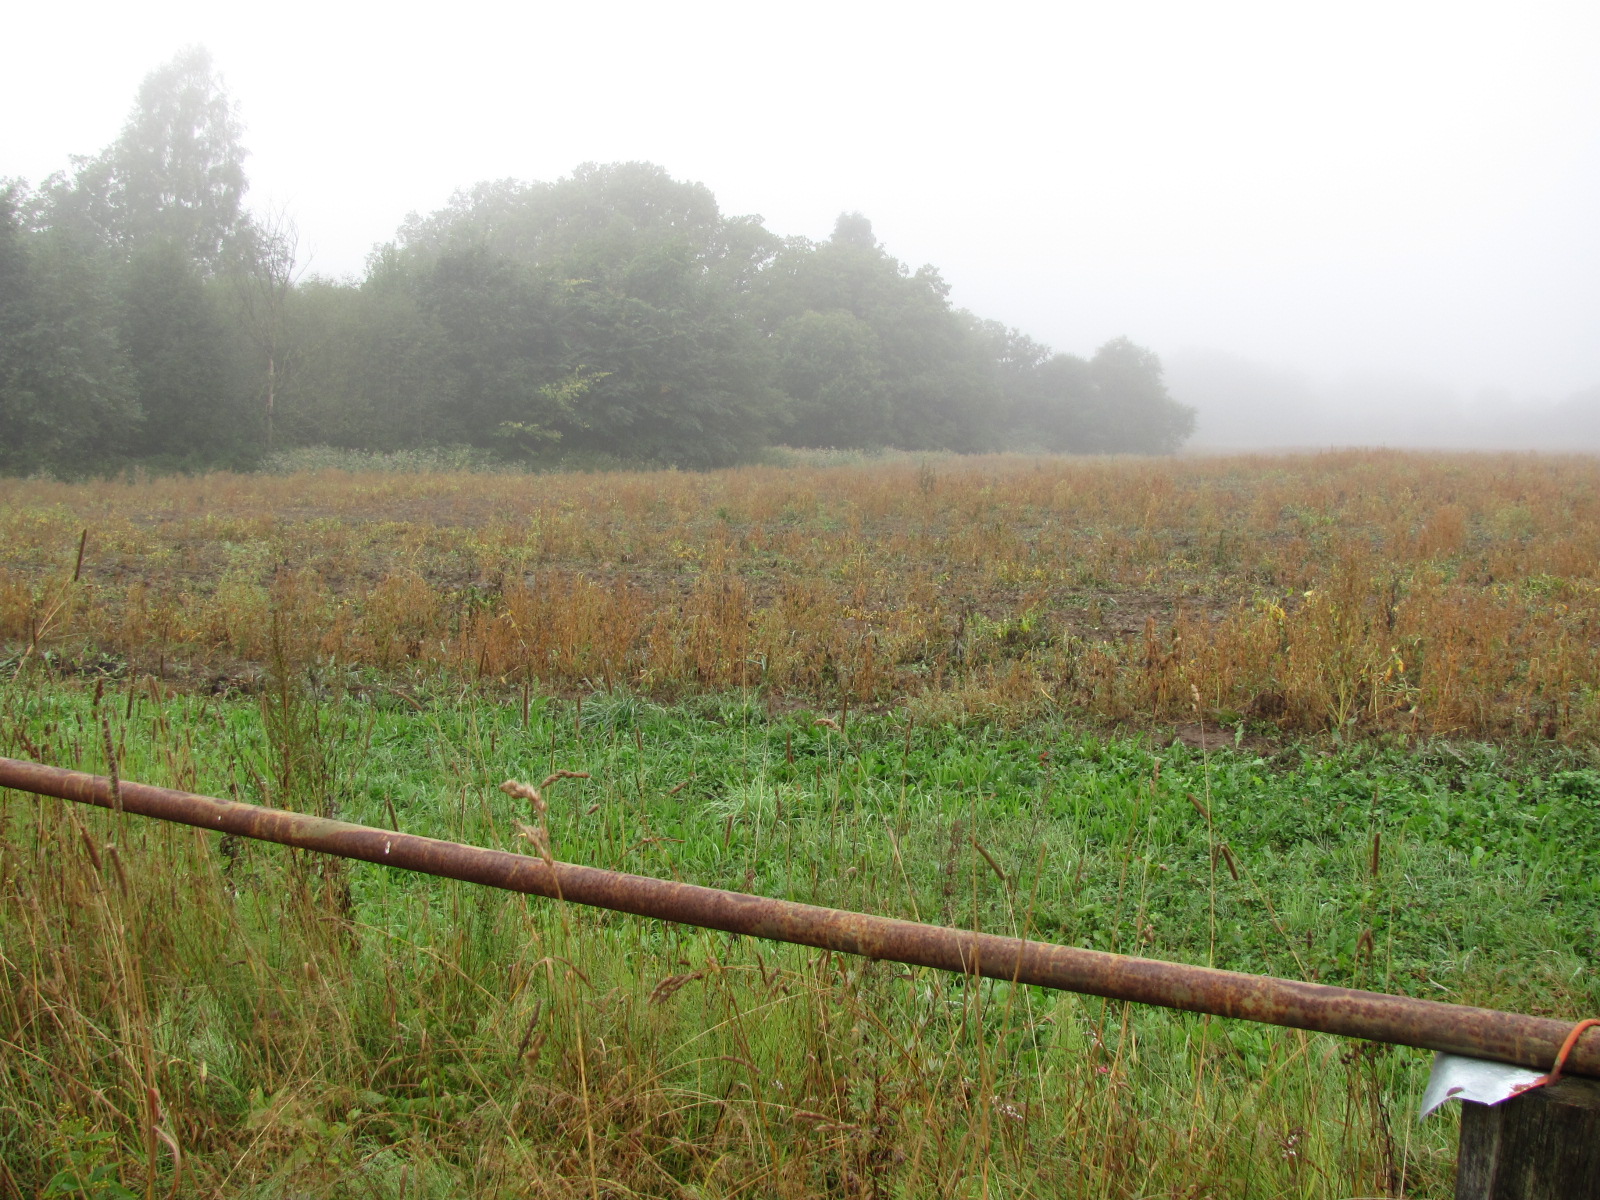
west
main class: Grassland
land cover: Grassland without tree/shrub cover
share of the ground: > 75 %
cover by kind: herbaceous plants 100 %
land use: Agriculture (excluding fallow land and kitchen gardens)
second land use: Residential
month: September
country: LV
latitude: 56.6152
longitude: 25.1843
